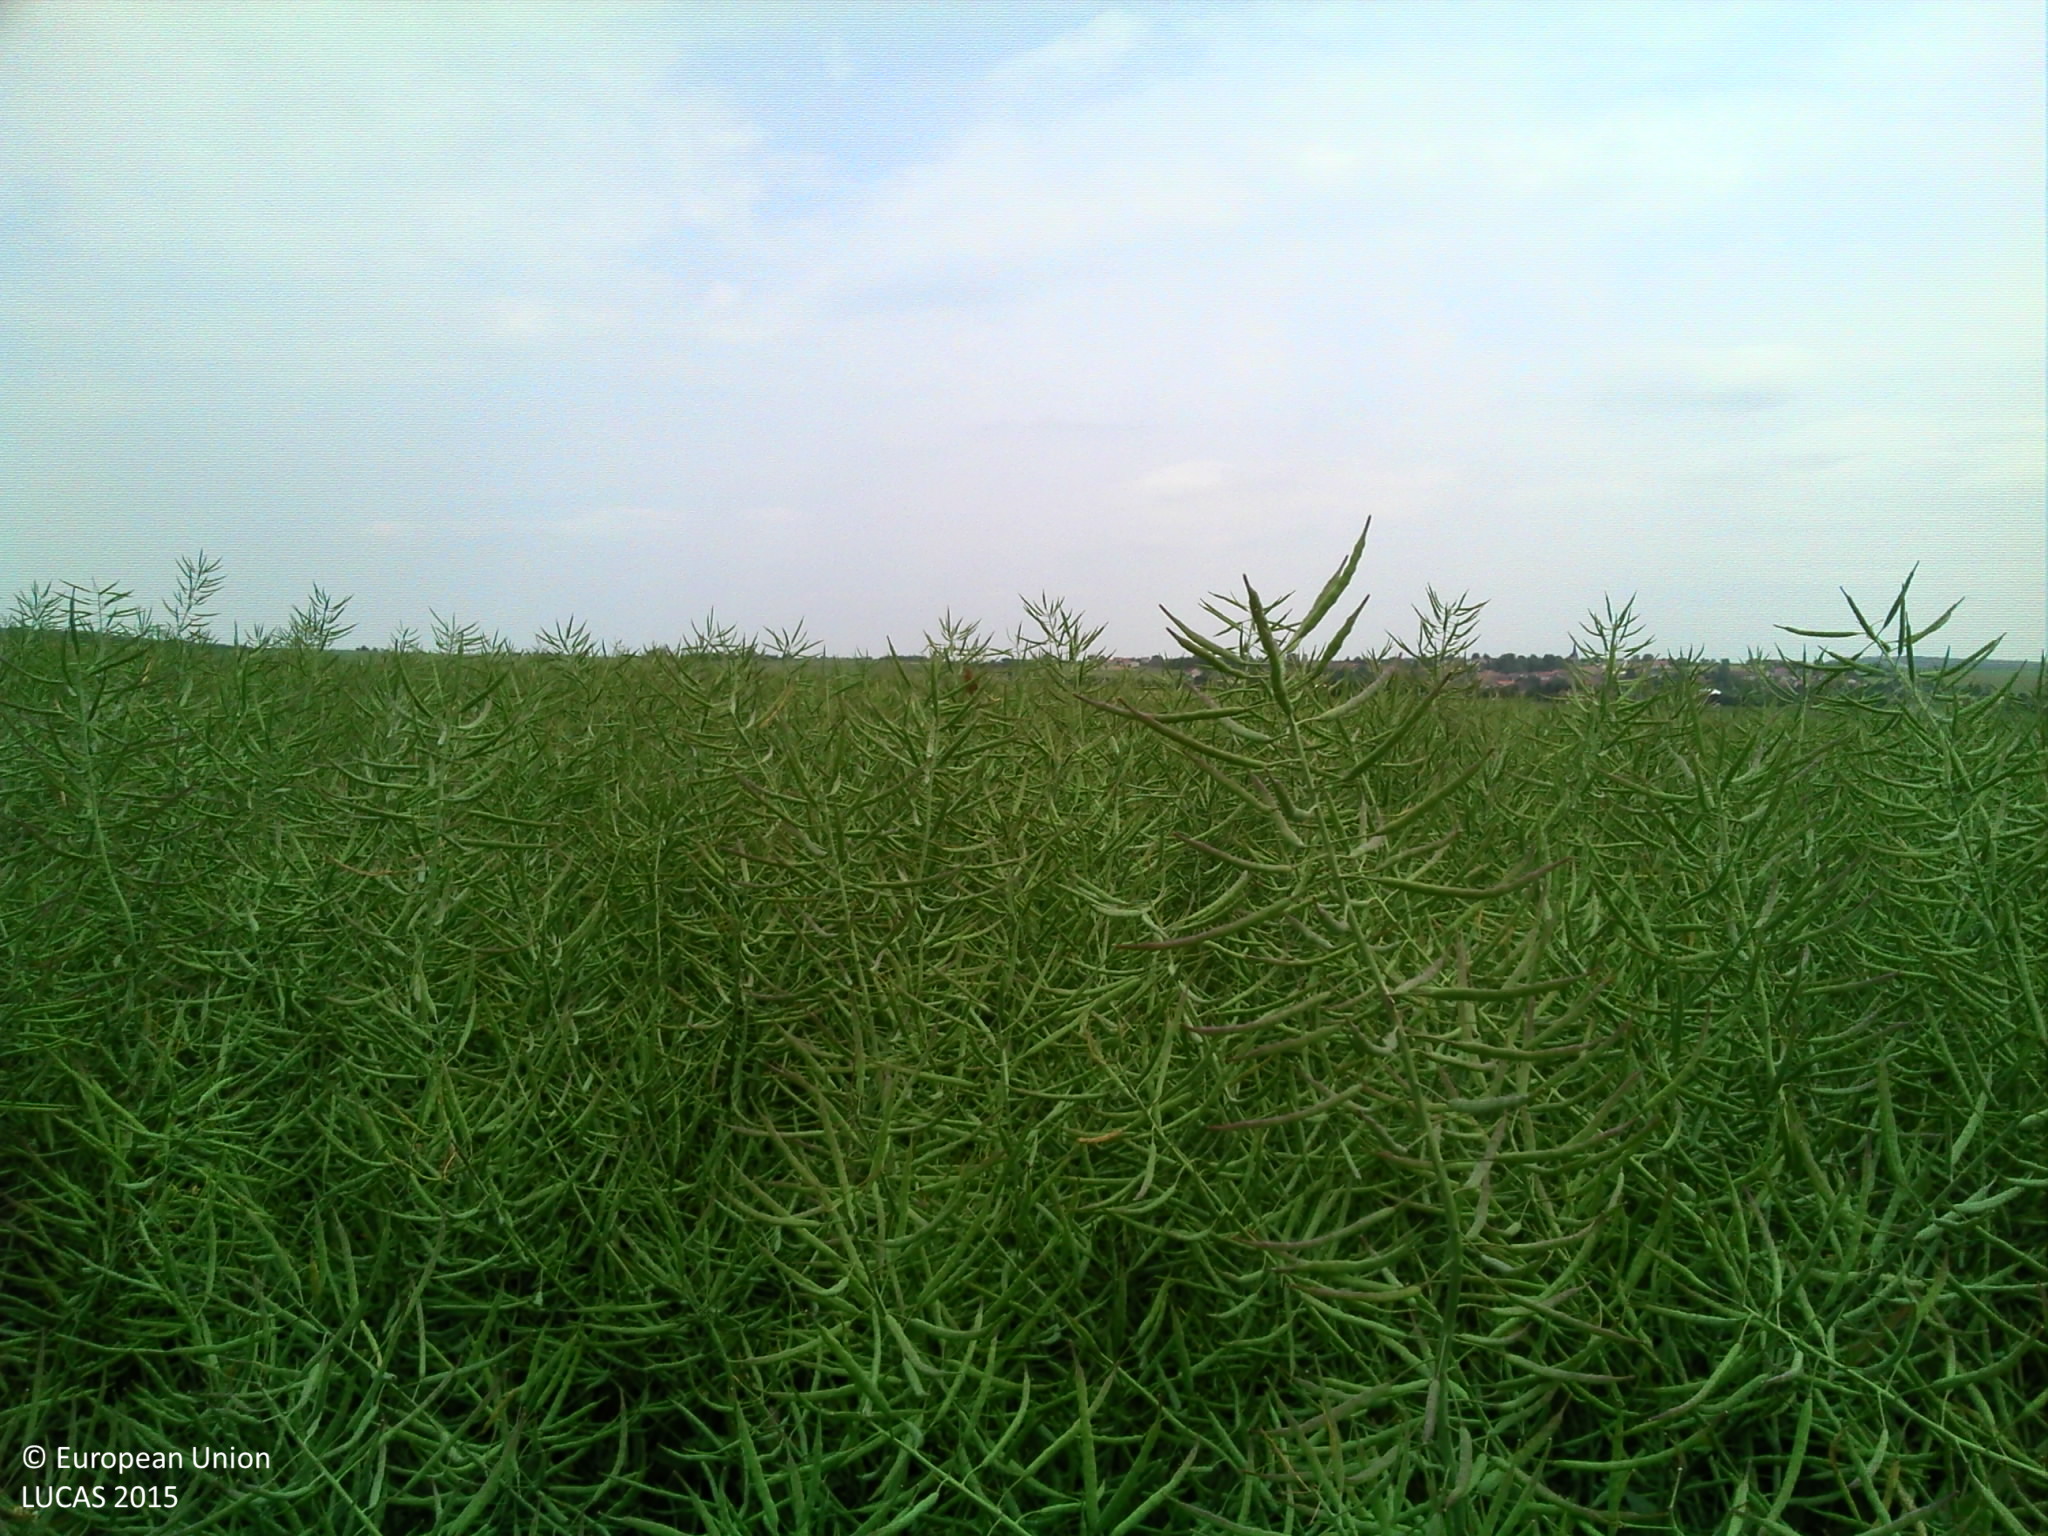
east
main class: Cropland
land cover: Rape and turnip rape
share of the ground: > 75 %
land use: Agriculture (excluding fallow land and kitchen gardens)
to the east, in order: Rape and turnip rape
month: June
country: FR
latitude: 48.5182
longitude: 6.1958
